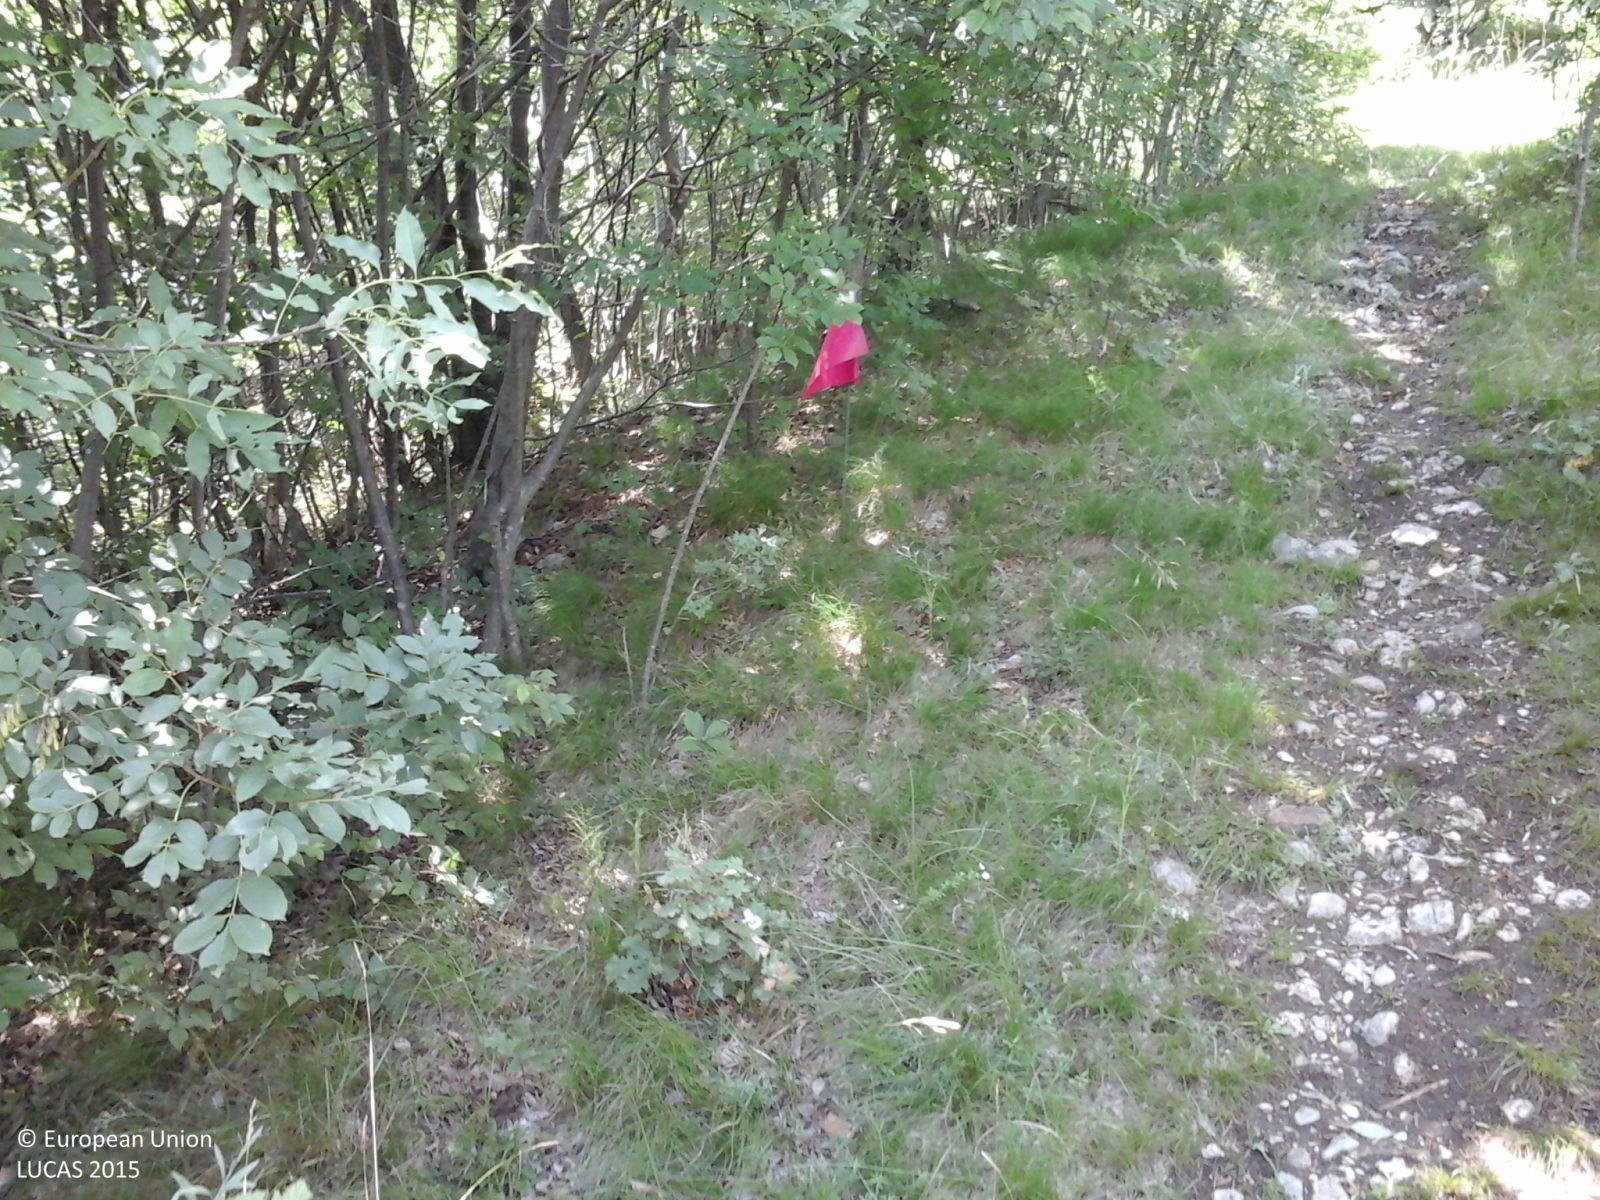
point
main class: Woodland
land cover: Broadleaved woodland
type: mesophytic deciduous forest
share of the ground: > 75 %
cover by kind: broadleaved forest trees 100 %
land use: Semi-natural and natural areas not in use
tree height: > 5 m
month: June
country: IT
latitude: 45.8110
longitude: 11.9404
